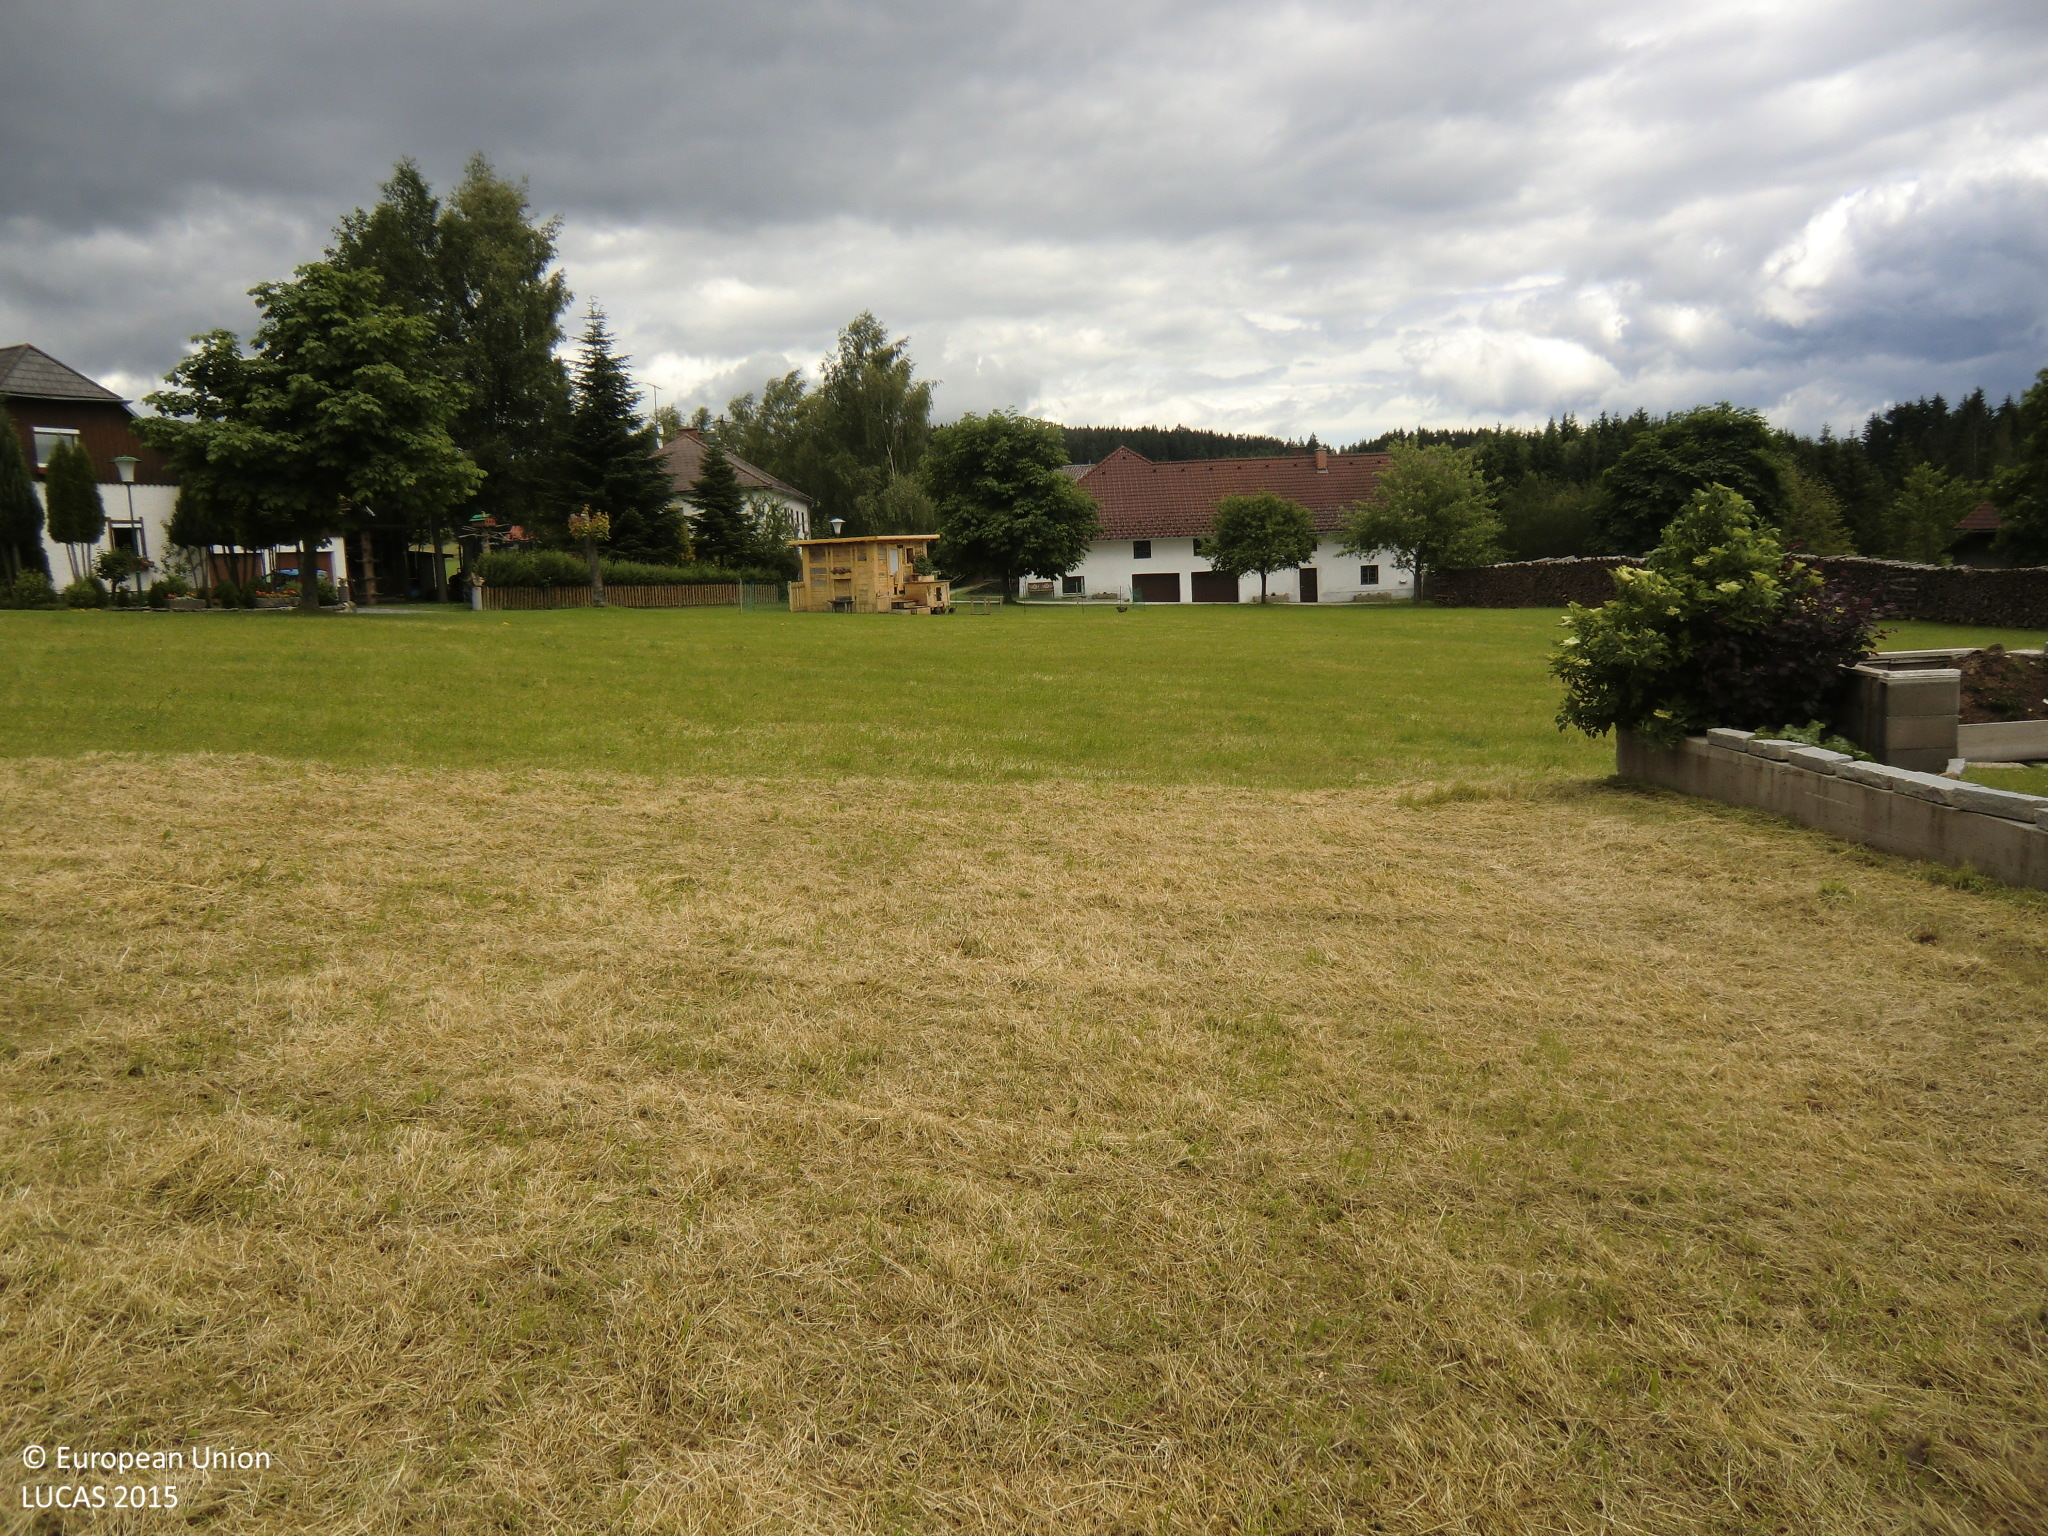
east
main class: Woodland
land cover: Broadleaved woodland
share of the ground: > 75 %
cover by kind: herbaceous plants 80 %, broadleaved forest trees 15 %, coniferous forest trees 5 %
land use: Residential
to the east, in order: Broadleaved woodland; Artificial constructions in urban areas; Grassland without tree/shrub cover; Pear fruit; Artificial constructions in urban areas; Grassland without tree/shrub cover; Spruce dominated coniferous woodland
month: June
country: AT
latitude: 48.5581
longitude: 14.6484
